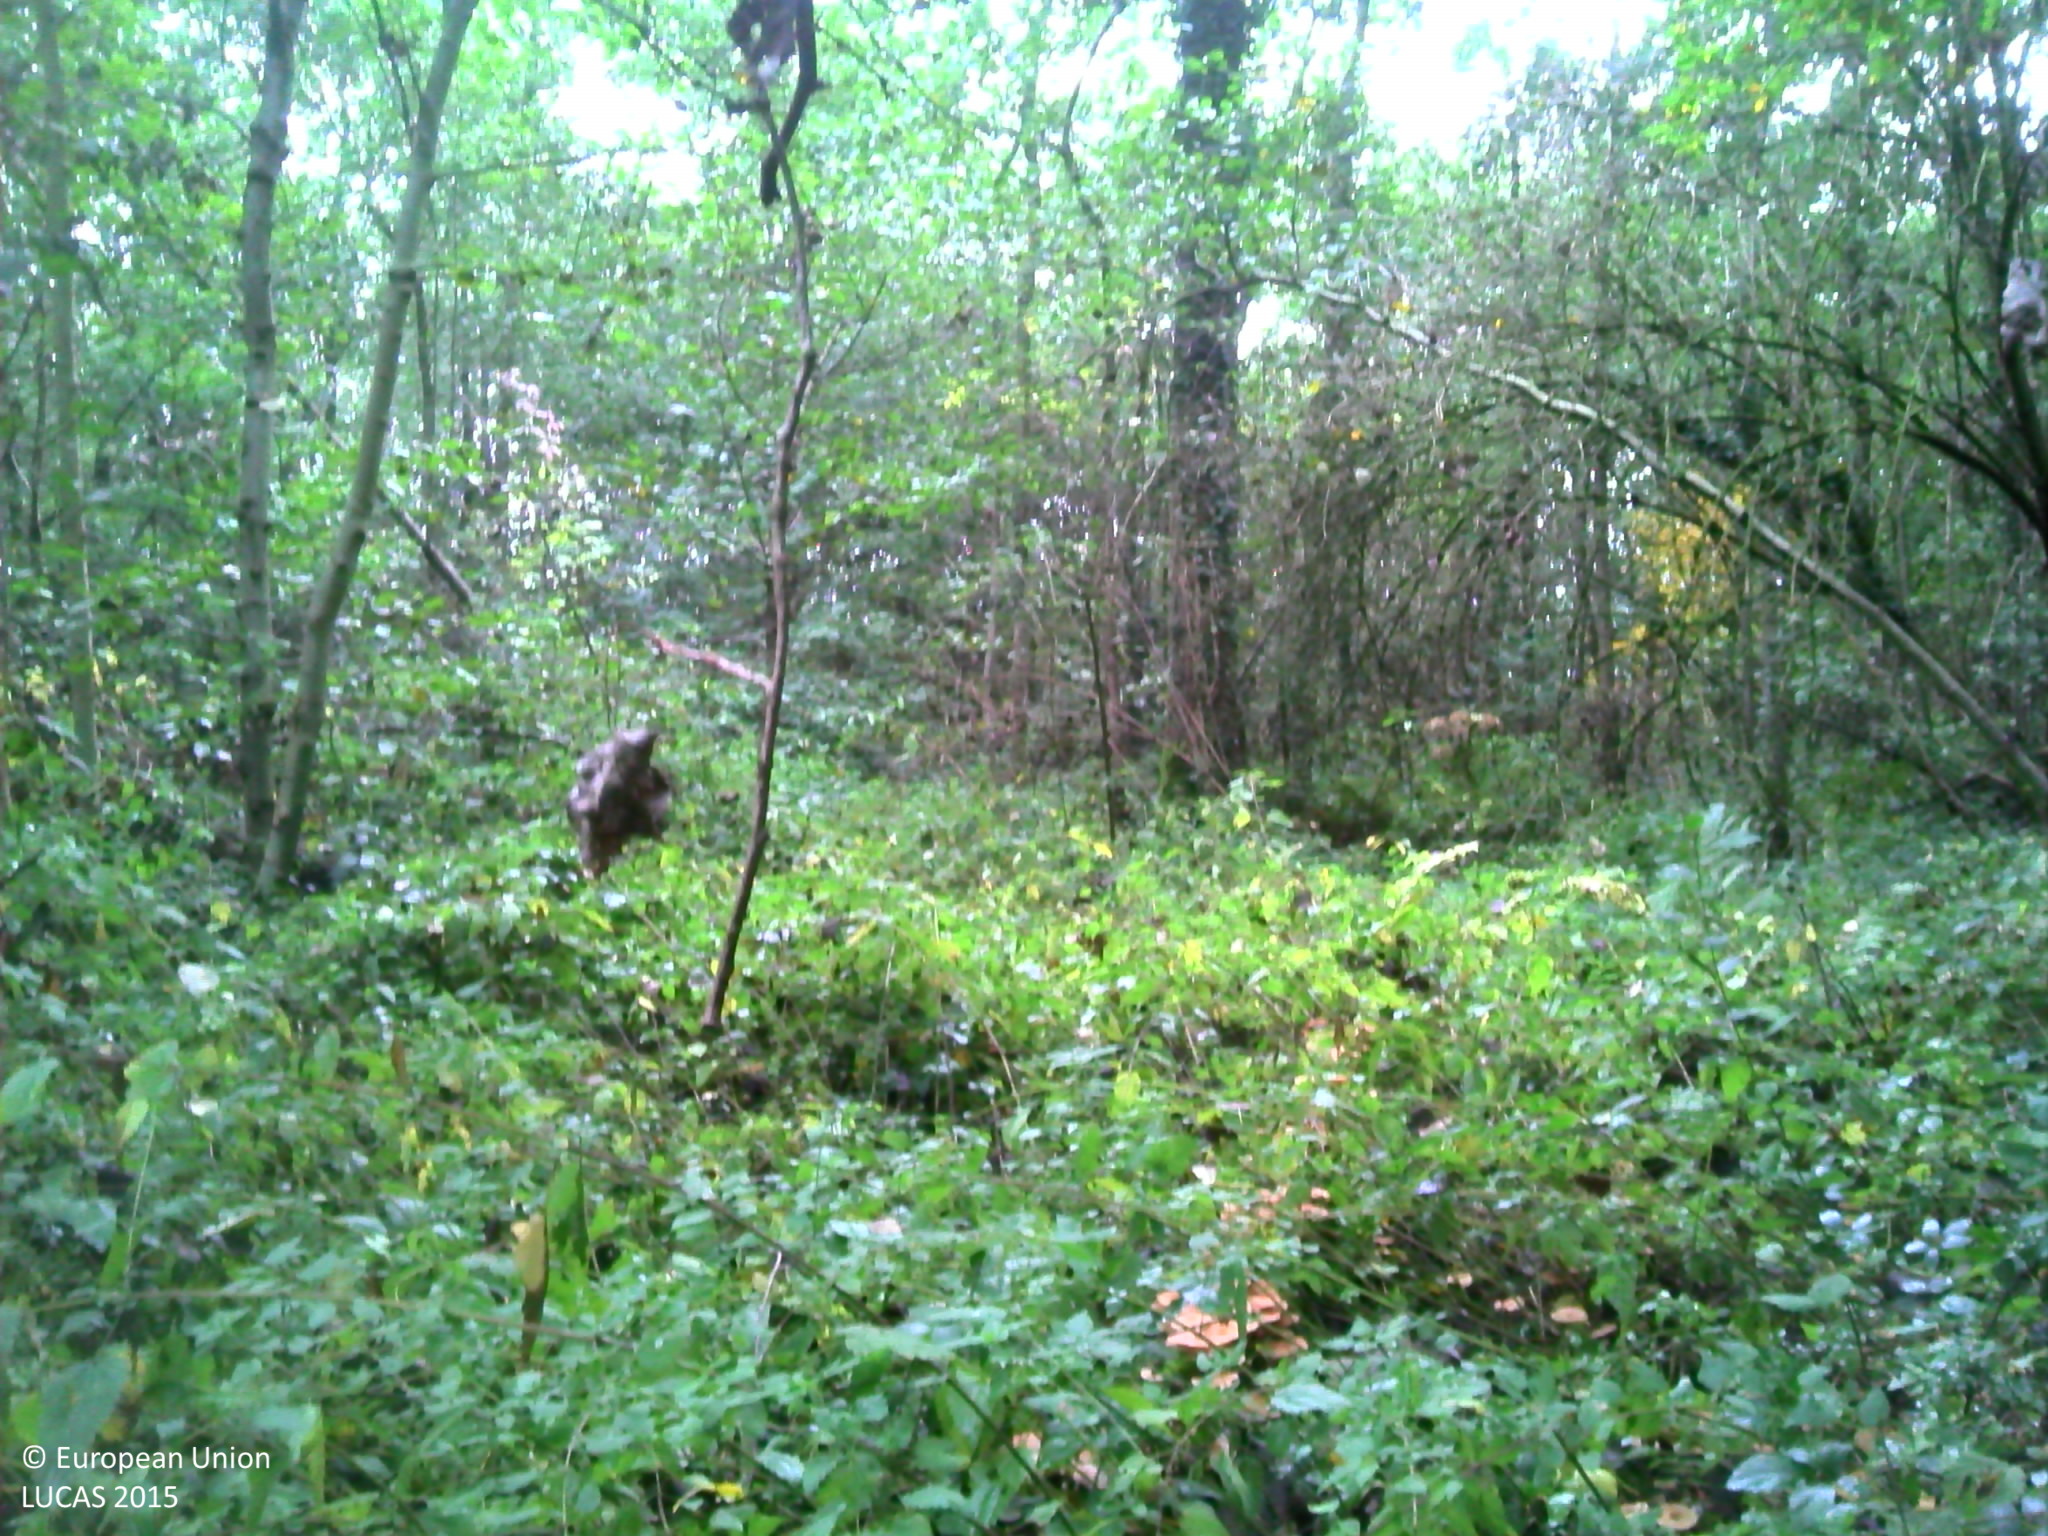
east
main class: Woodland
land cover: Broadleaved woodland
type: non-riverine alder, birch or aspen forest
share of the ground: > 75 %
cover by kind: broadleaved forest trees 80 %, herbaceous plants 20 %
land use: Forestry
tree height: > 5 m
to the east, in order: Broadleaved woodland; Ditches and canals; Artificial constructions in urban areas; Grassland without tree/shrub cover; Single bushes/trees; Grassland without tree/shrub cover
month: October
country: BE
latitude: 51.0216
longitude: 4.8216
